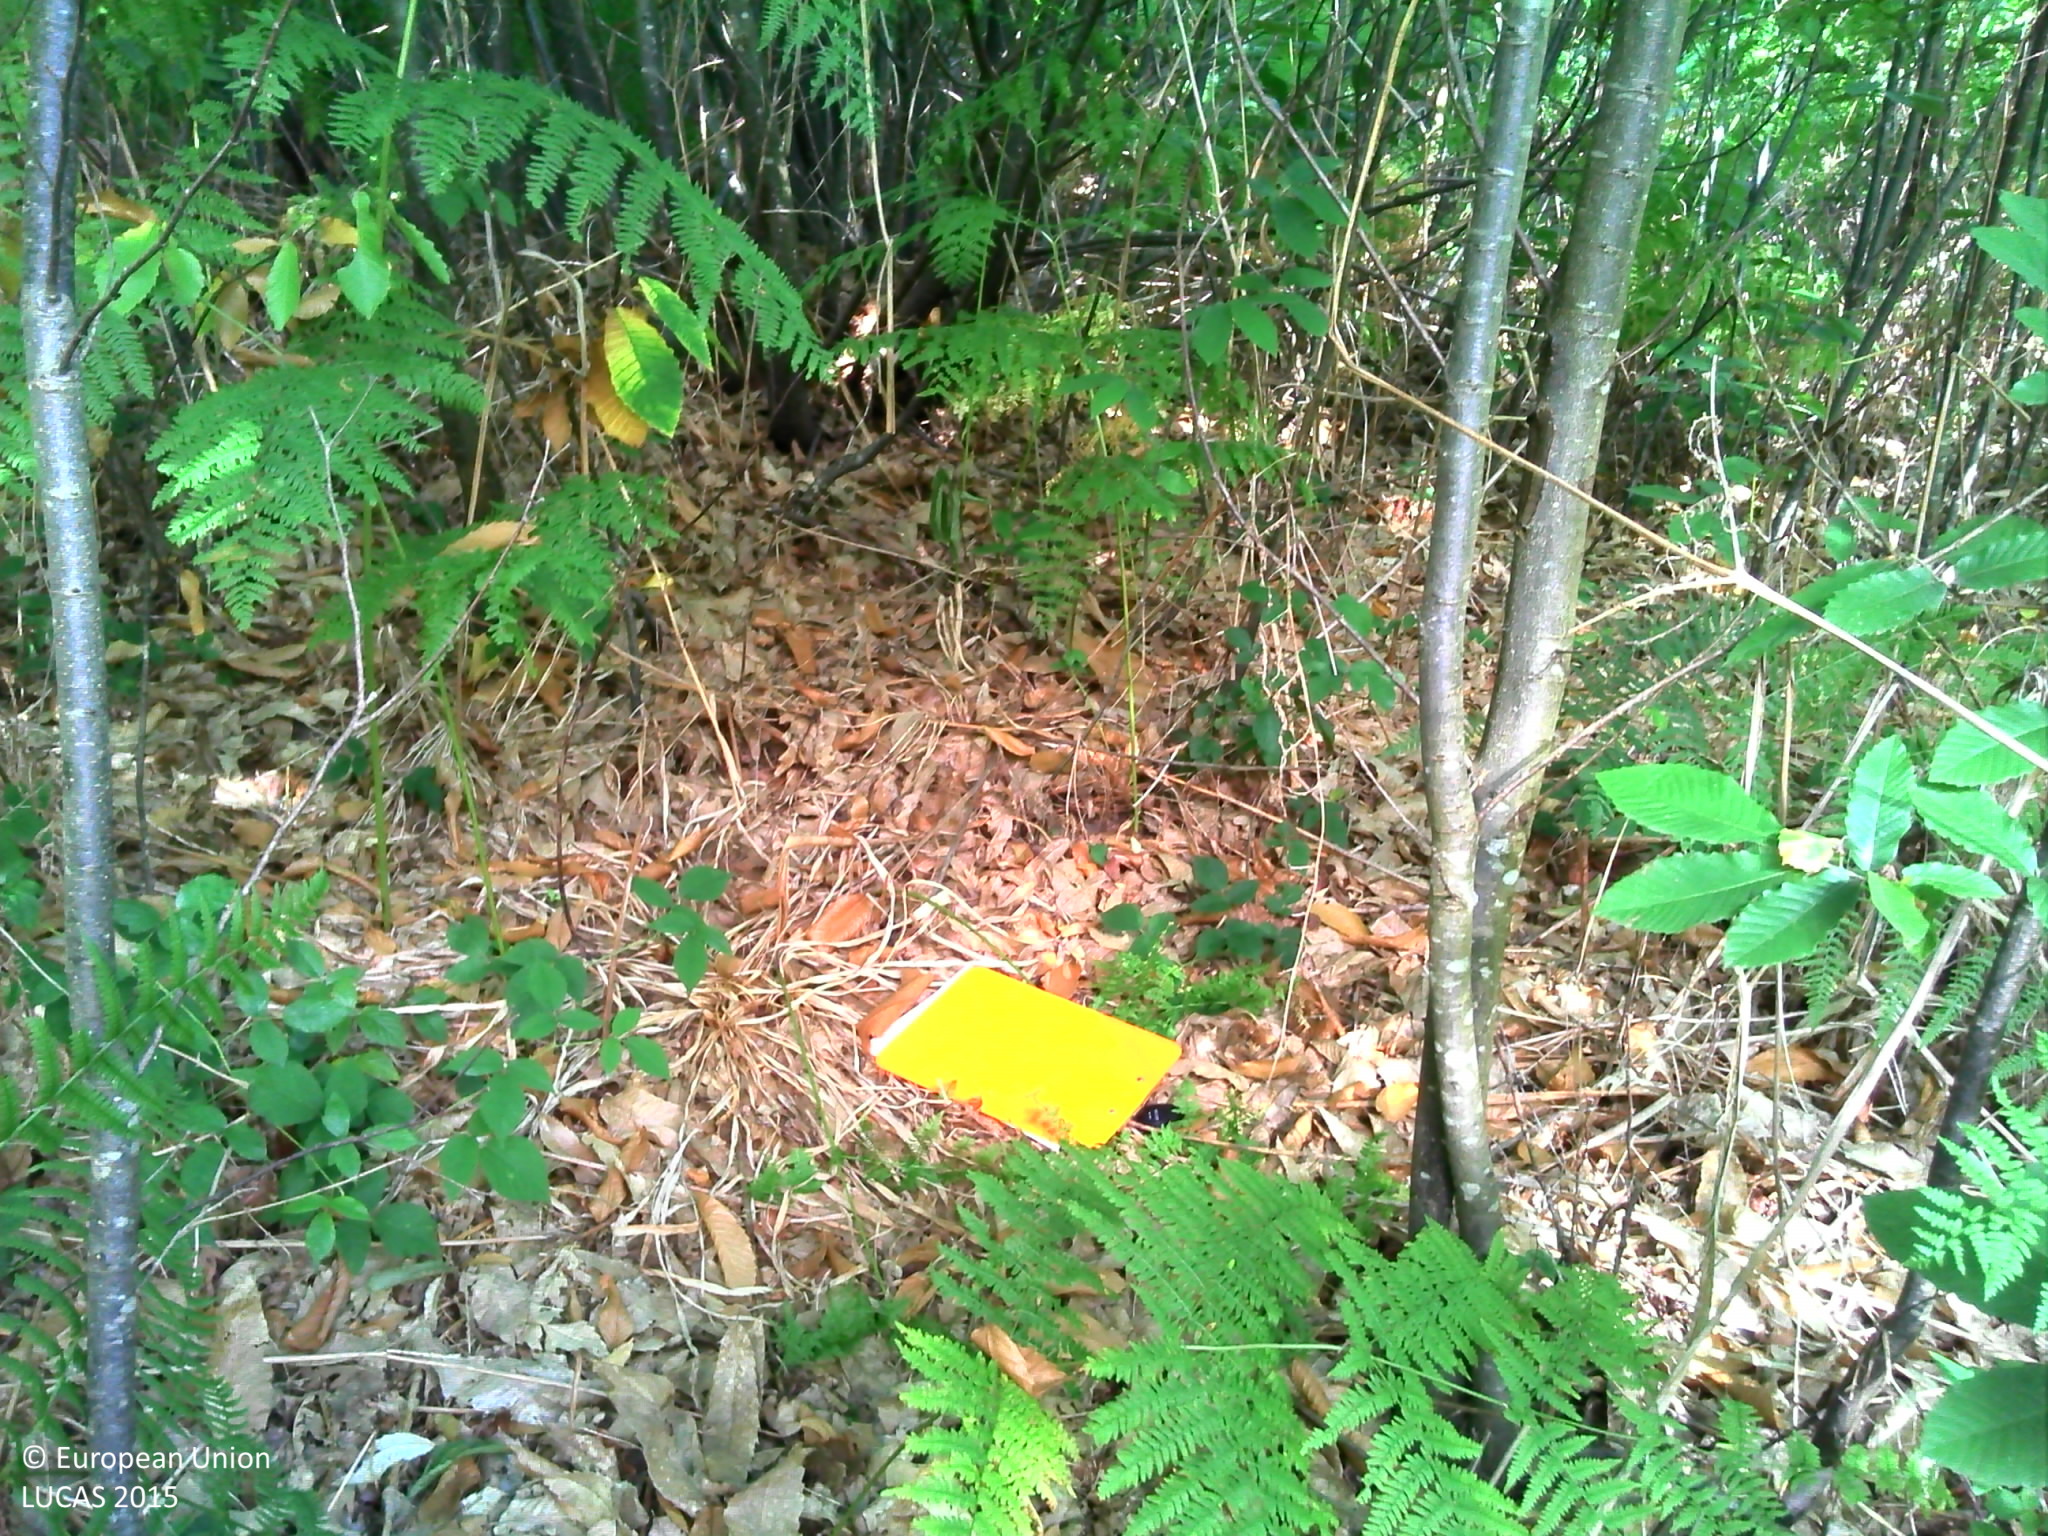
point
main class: Woodland
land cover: Broadleaved woodland
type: thermophilous deciduous forest
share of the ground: > 75 %
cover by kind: broadleaved forest trees 80 %, herbaceous plants 10 %, shrubs 5 %, lichens and mosses 5 %
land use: Forestry
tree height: > 5 m
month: July
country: FR
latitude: 45.0129
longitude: 0.8177
